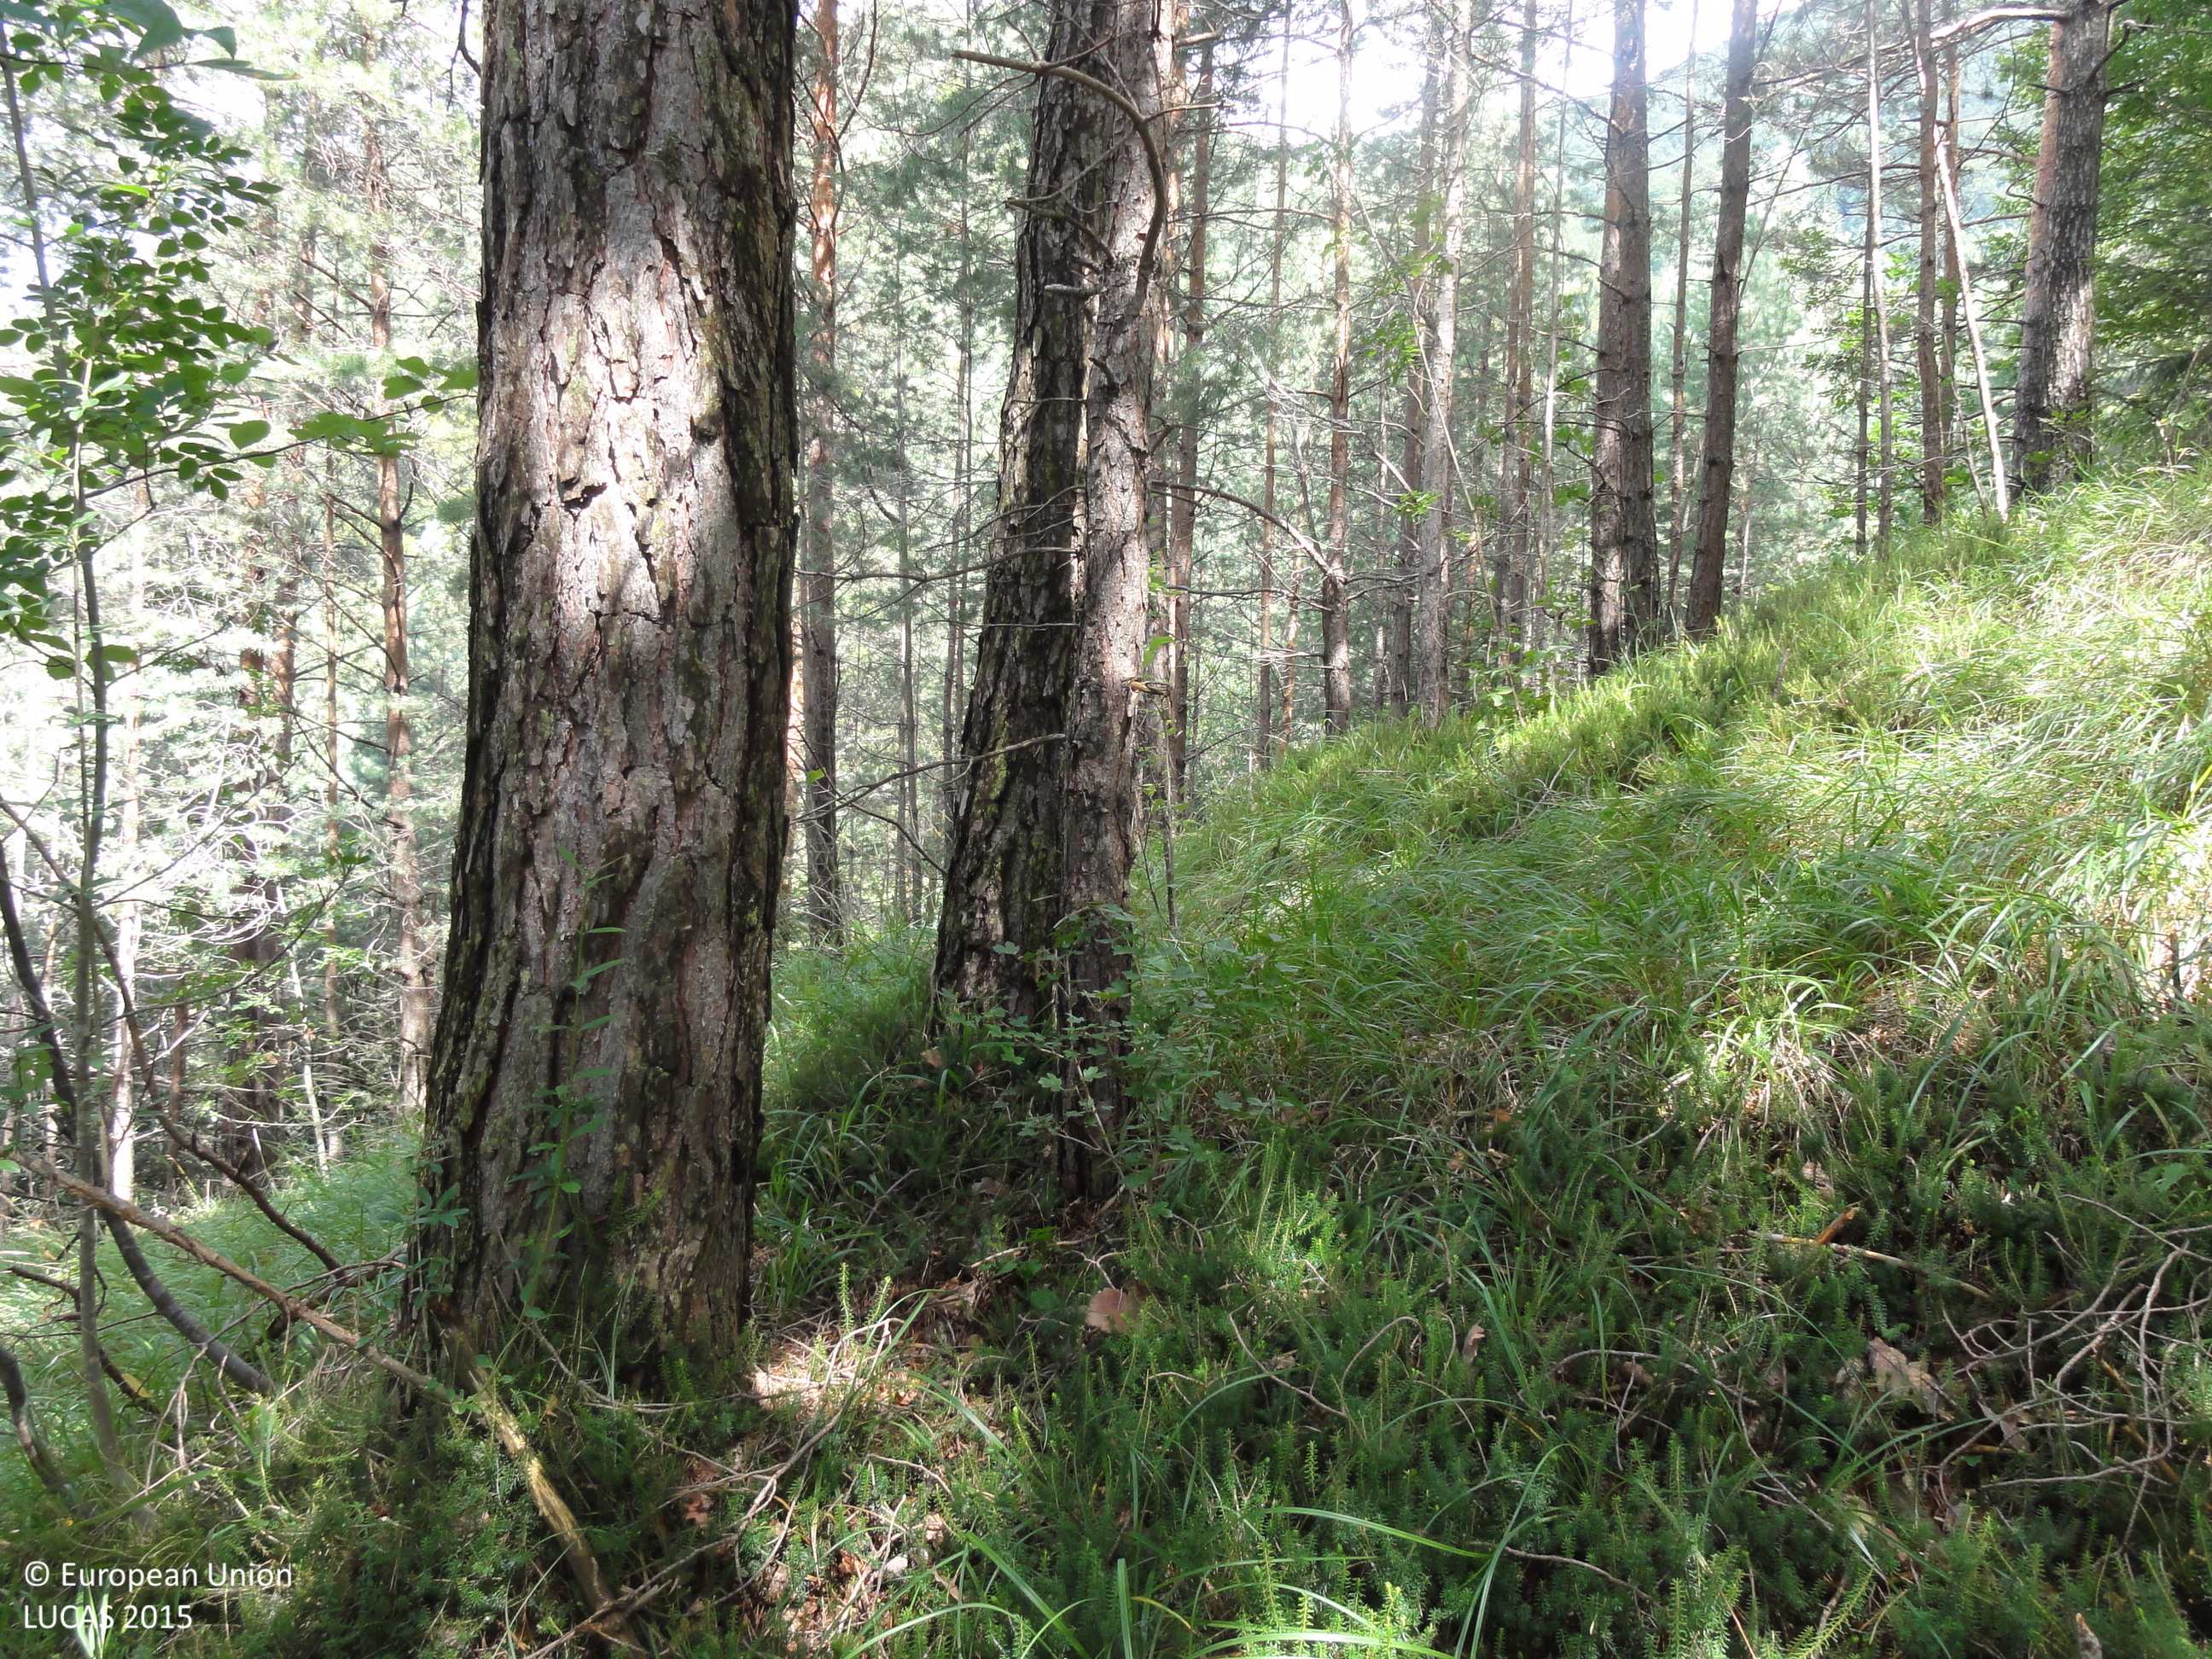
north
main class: Woodland
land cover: Pine dominated mixed woodland
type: hemiboreal forest and nemoral coniferous forest and mixed broadleaved-coniferous forest
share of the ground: > 75 %
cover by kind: coniferous forest trees 70 %, broadleaved forest trees 30 %
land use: Forestry
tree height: > 5 m
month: August
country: SI
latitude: 46.0886
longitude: 15.0280
